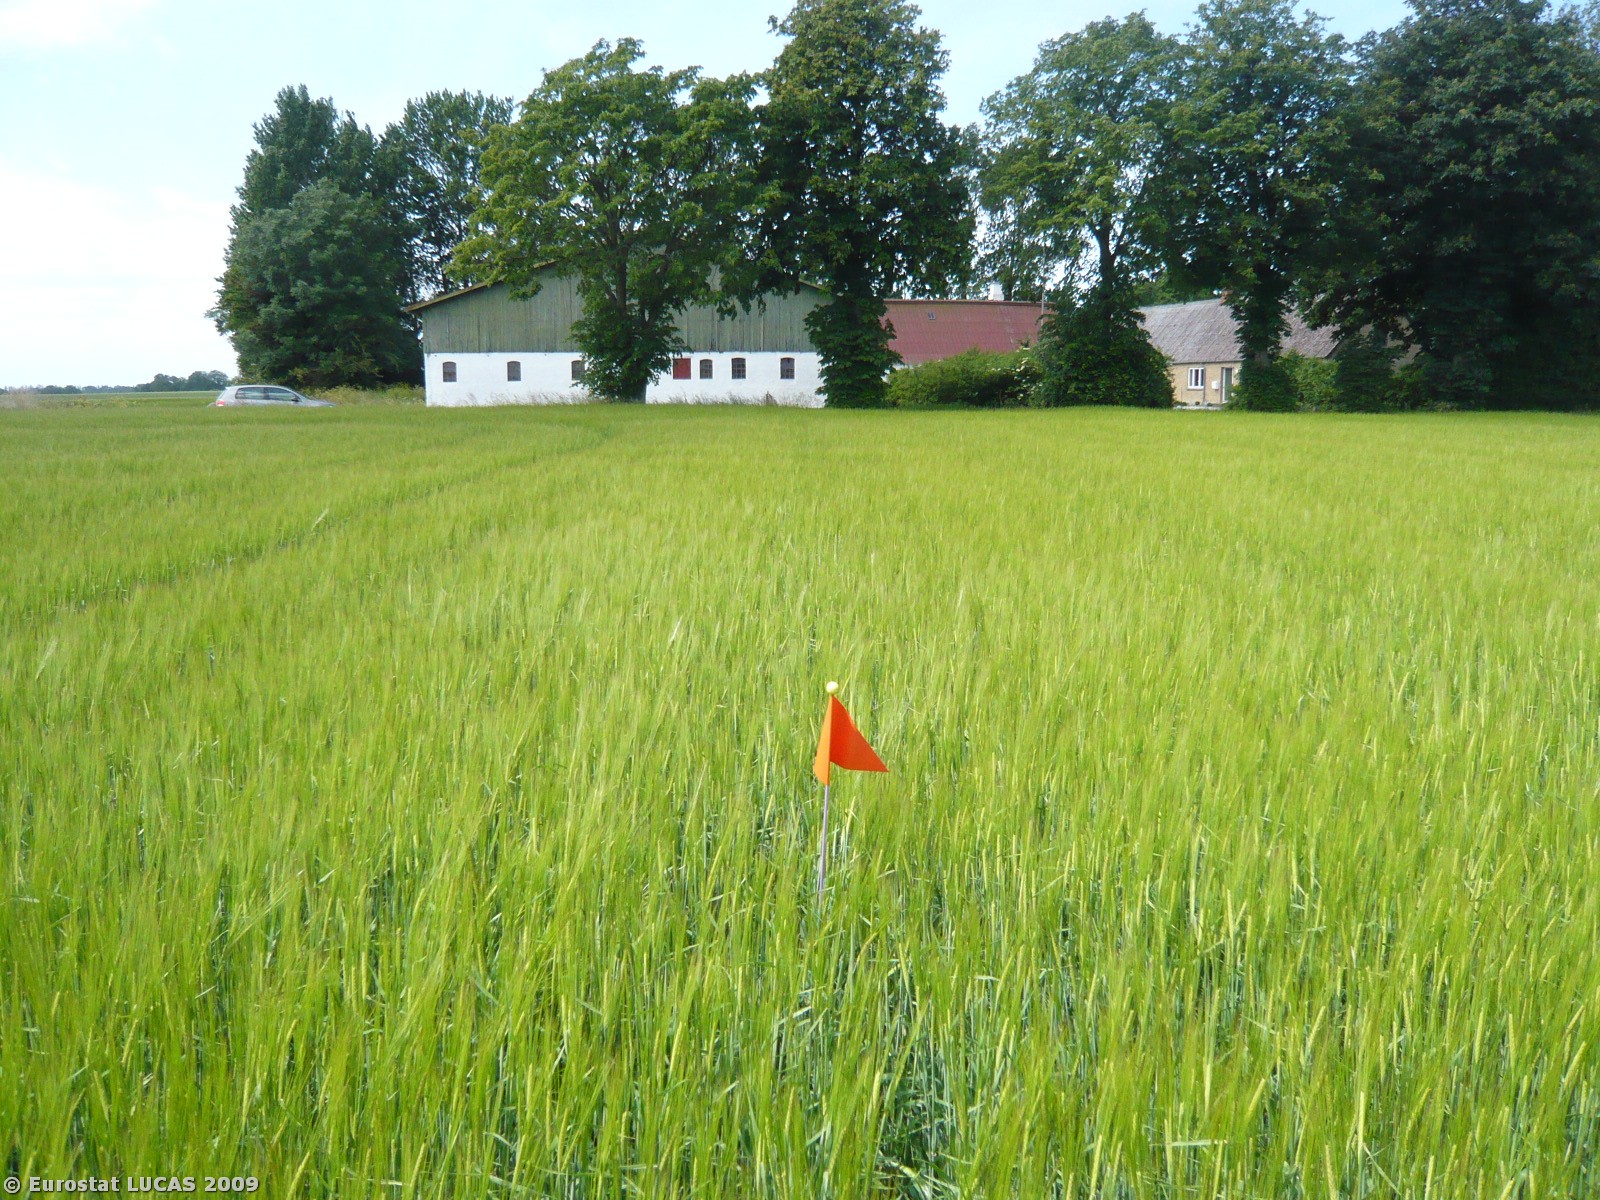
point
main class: Cropland
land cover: Barley
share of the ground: > 75 %
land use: Agriculture (excluding fallow land and kitchen gardens)
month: June
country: DK
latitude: 54.7986
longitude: 11.1347
